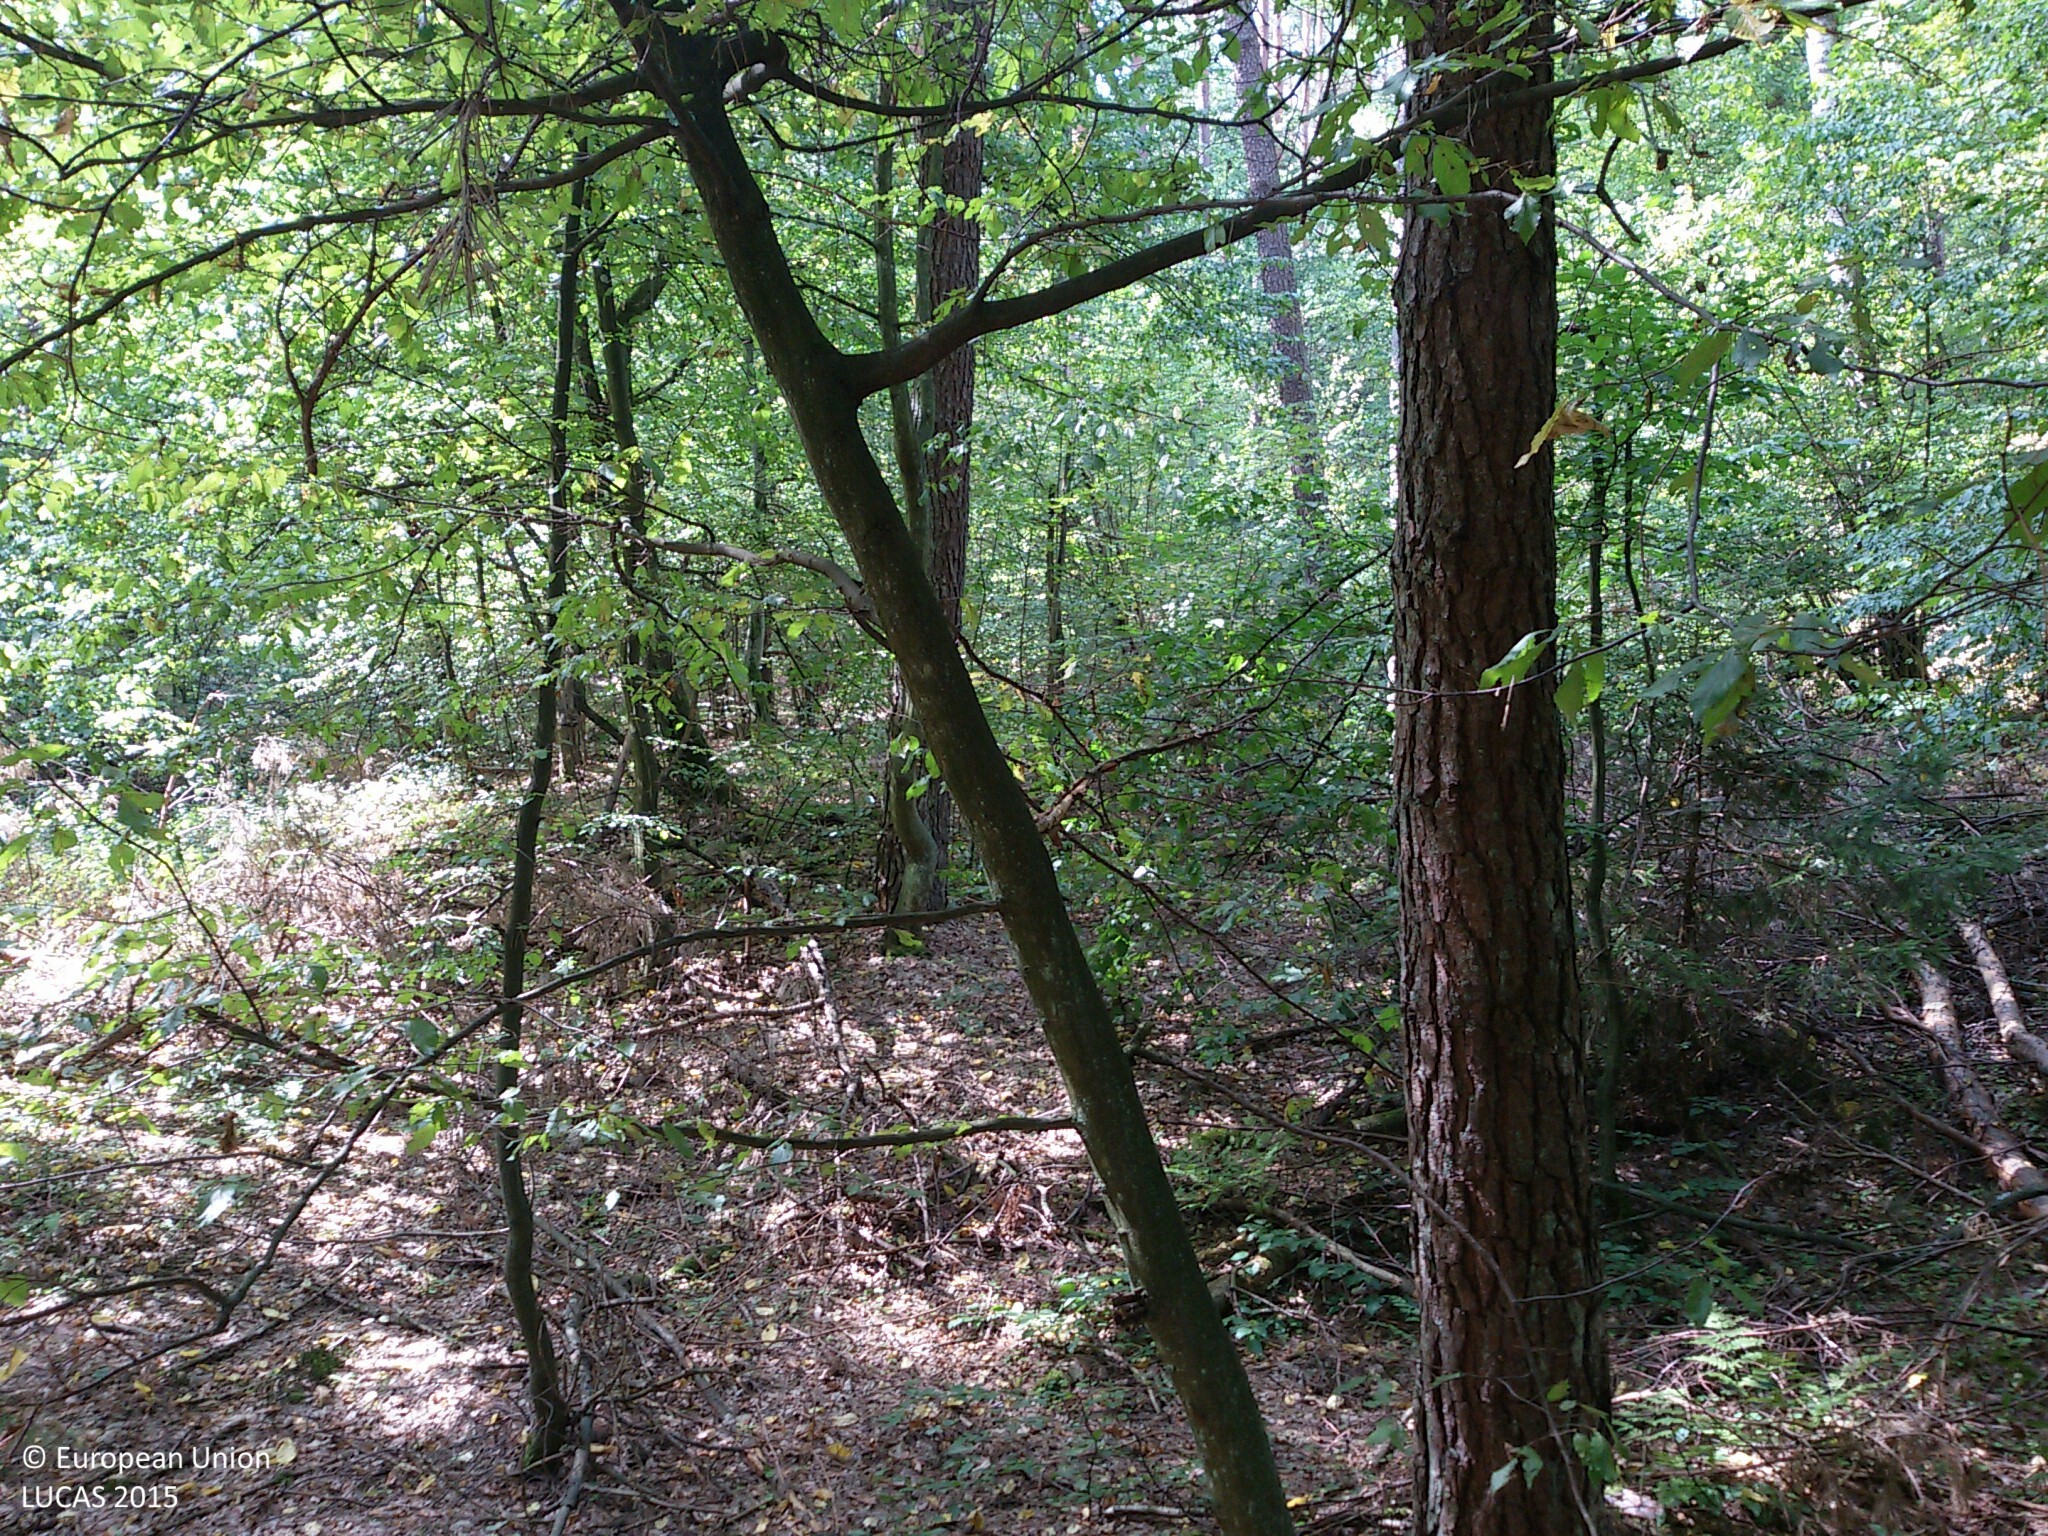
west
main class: Woodland
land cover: Pine dominated mixed woodland
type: hemiboreal forest and nemoral coniferous forest and mixed broadleaved-coniferous forest
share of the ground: > 75 %
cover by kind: coniferous forest trees 65 %, broadleaved forest trees 25 %, herbaceous plants 5 %, unconsolidated bare surface 5 %
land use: Forestry
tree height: > 5 m
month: August
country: PL
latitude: 53.5712
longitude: 20.1660
